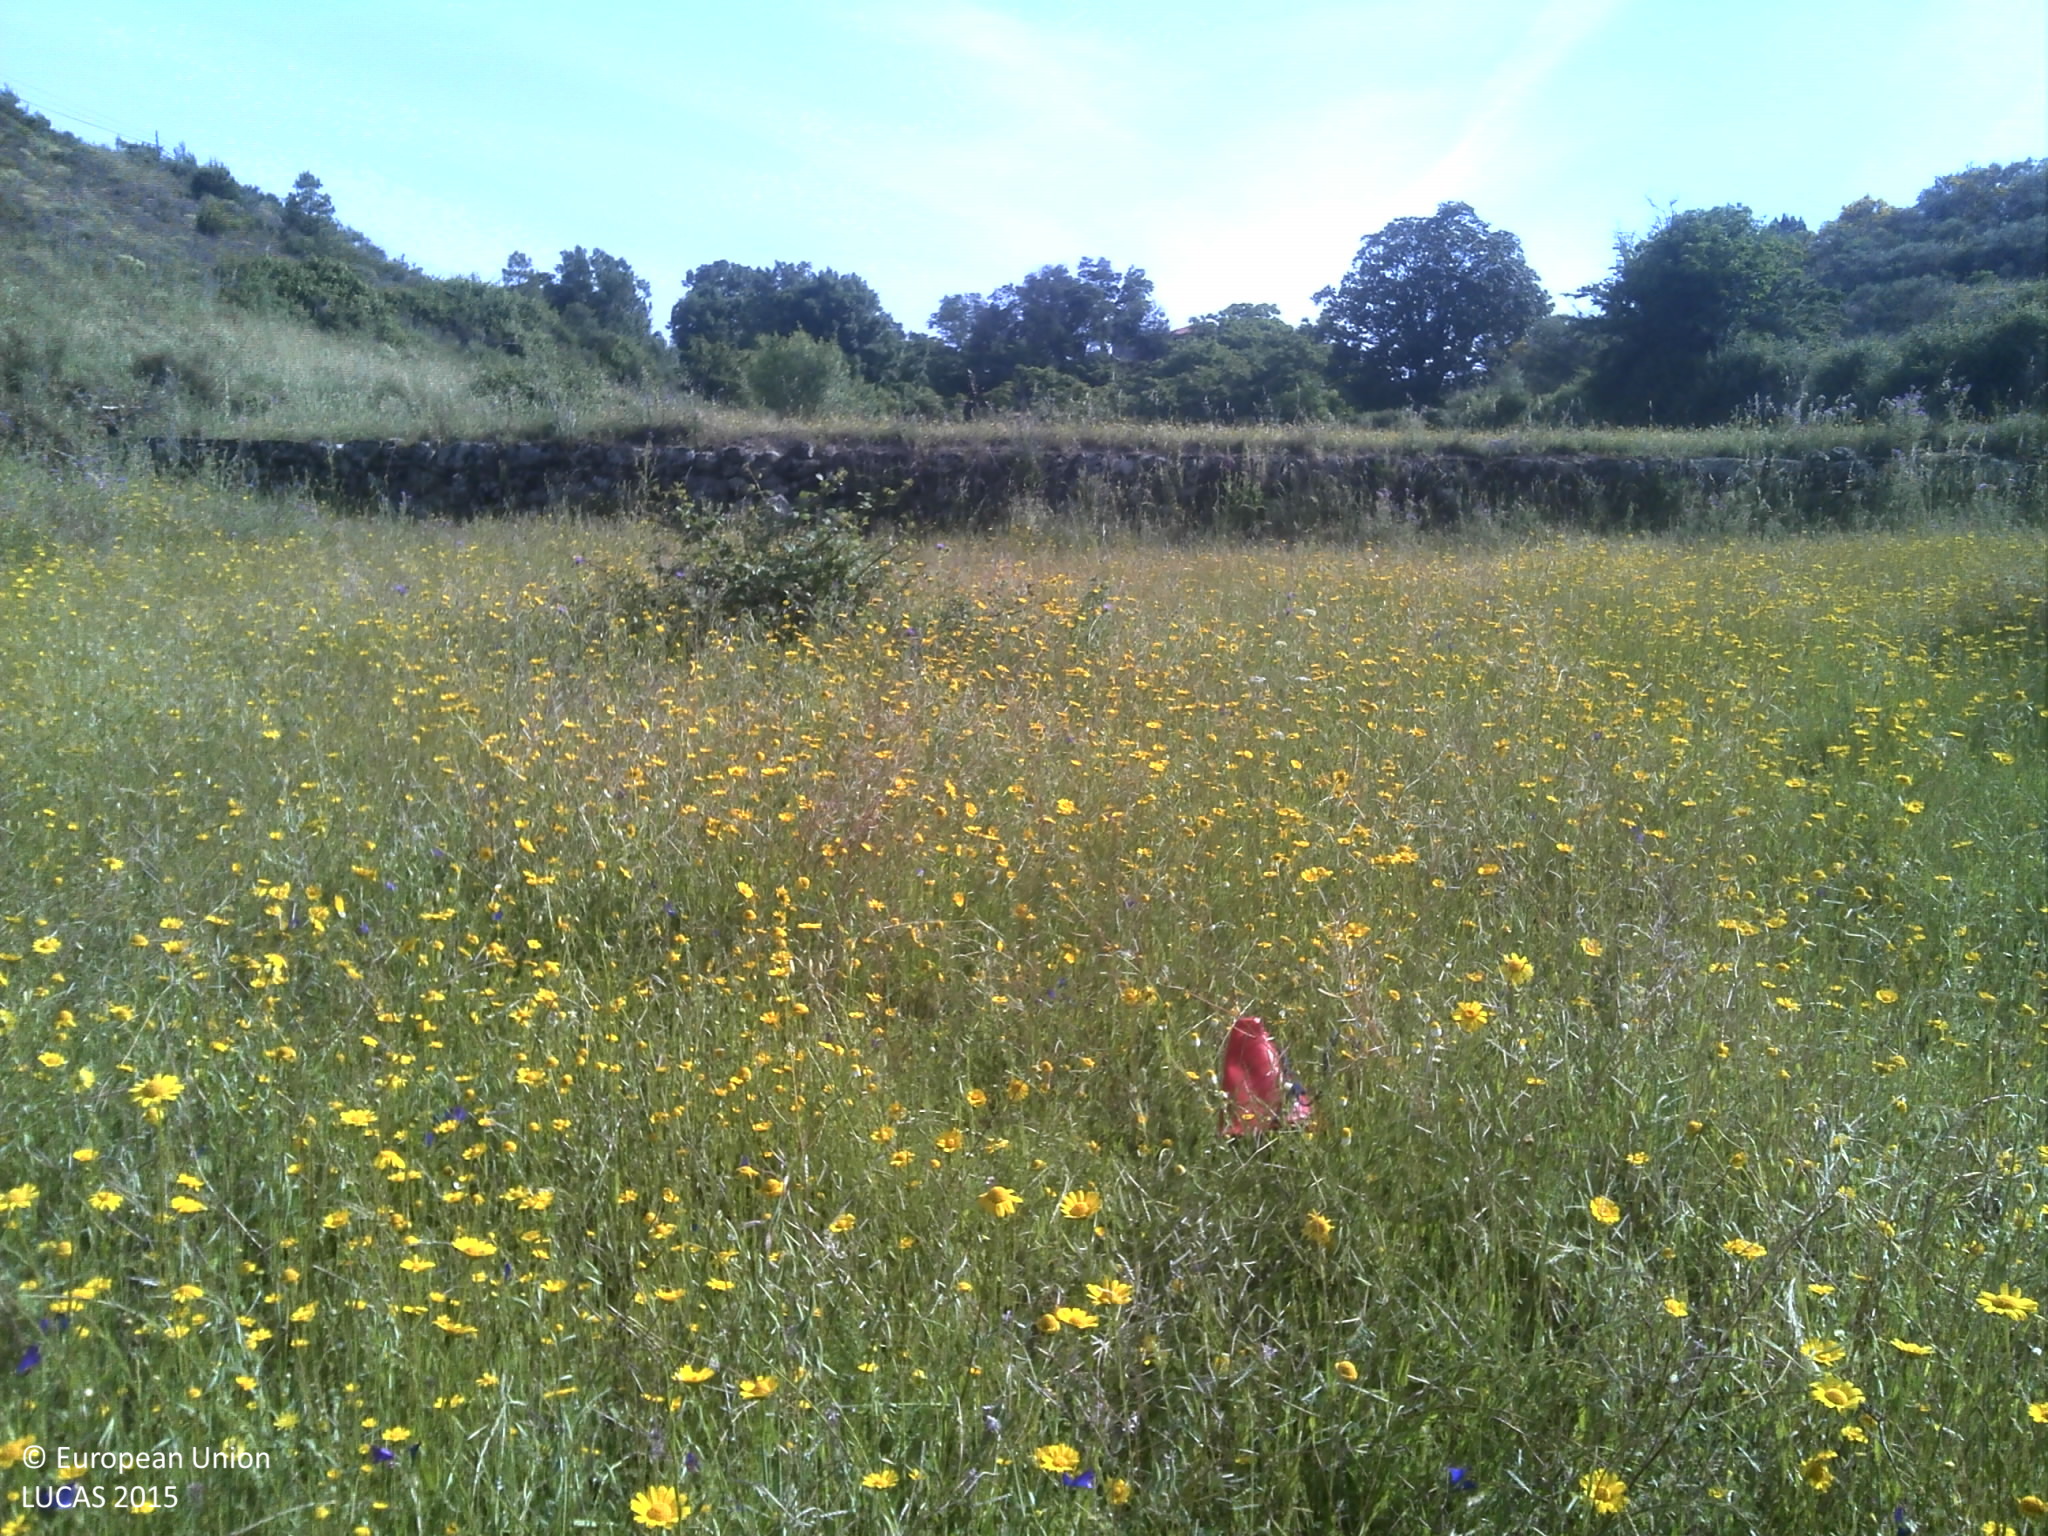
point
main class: Grassland
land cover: Grassland without tree/shrub cover
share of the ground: 50 - 75 %
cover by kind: herbaceous plants 65 %, unconsolidated bare surface 25 %
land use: Agriculture (excluding fallow land and kitchen gardens)
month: May
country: PT
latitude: 40.6173
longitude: -7.4038
